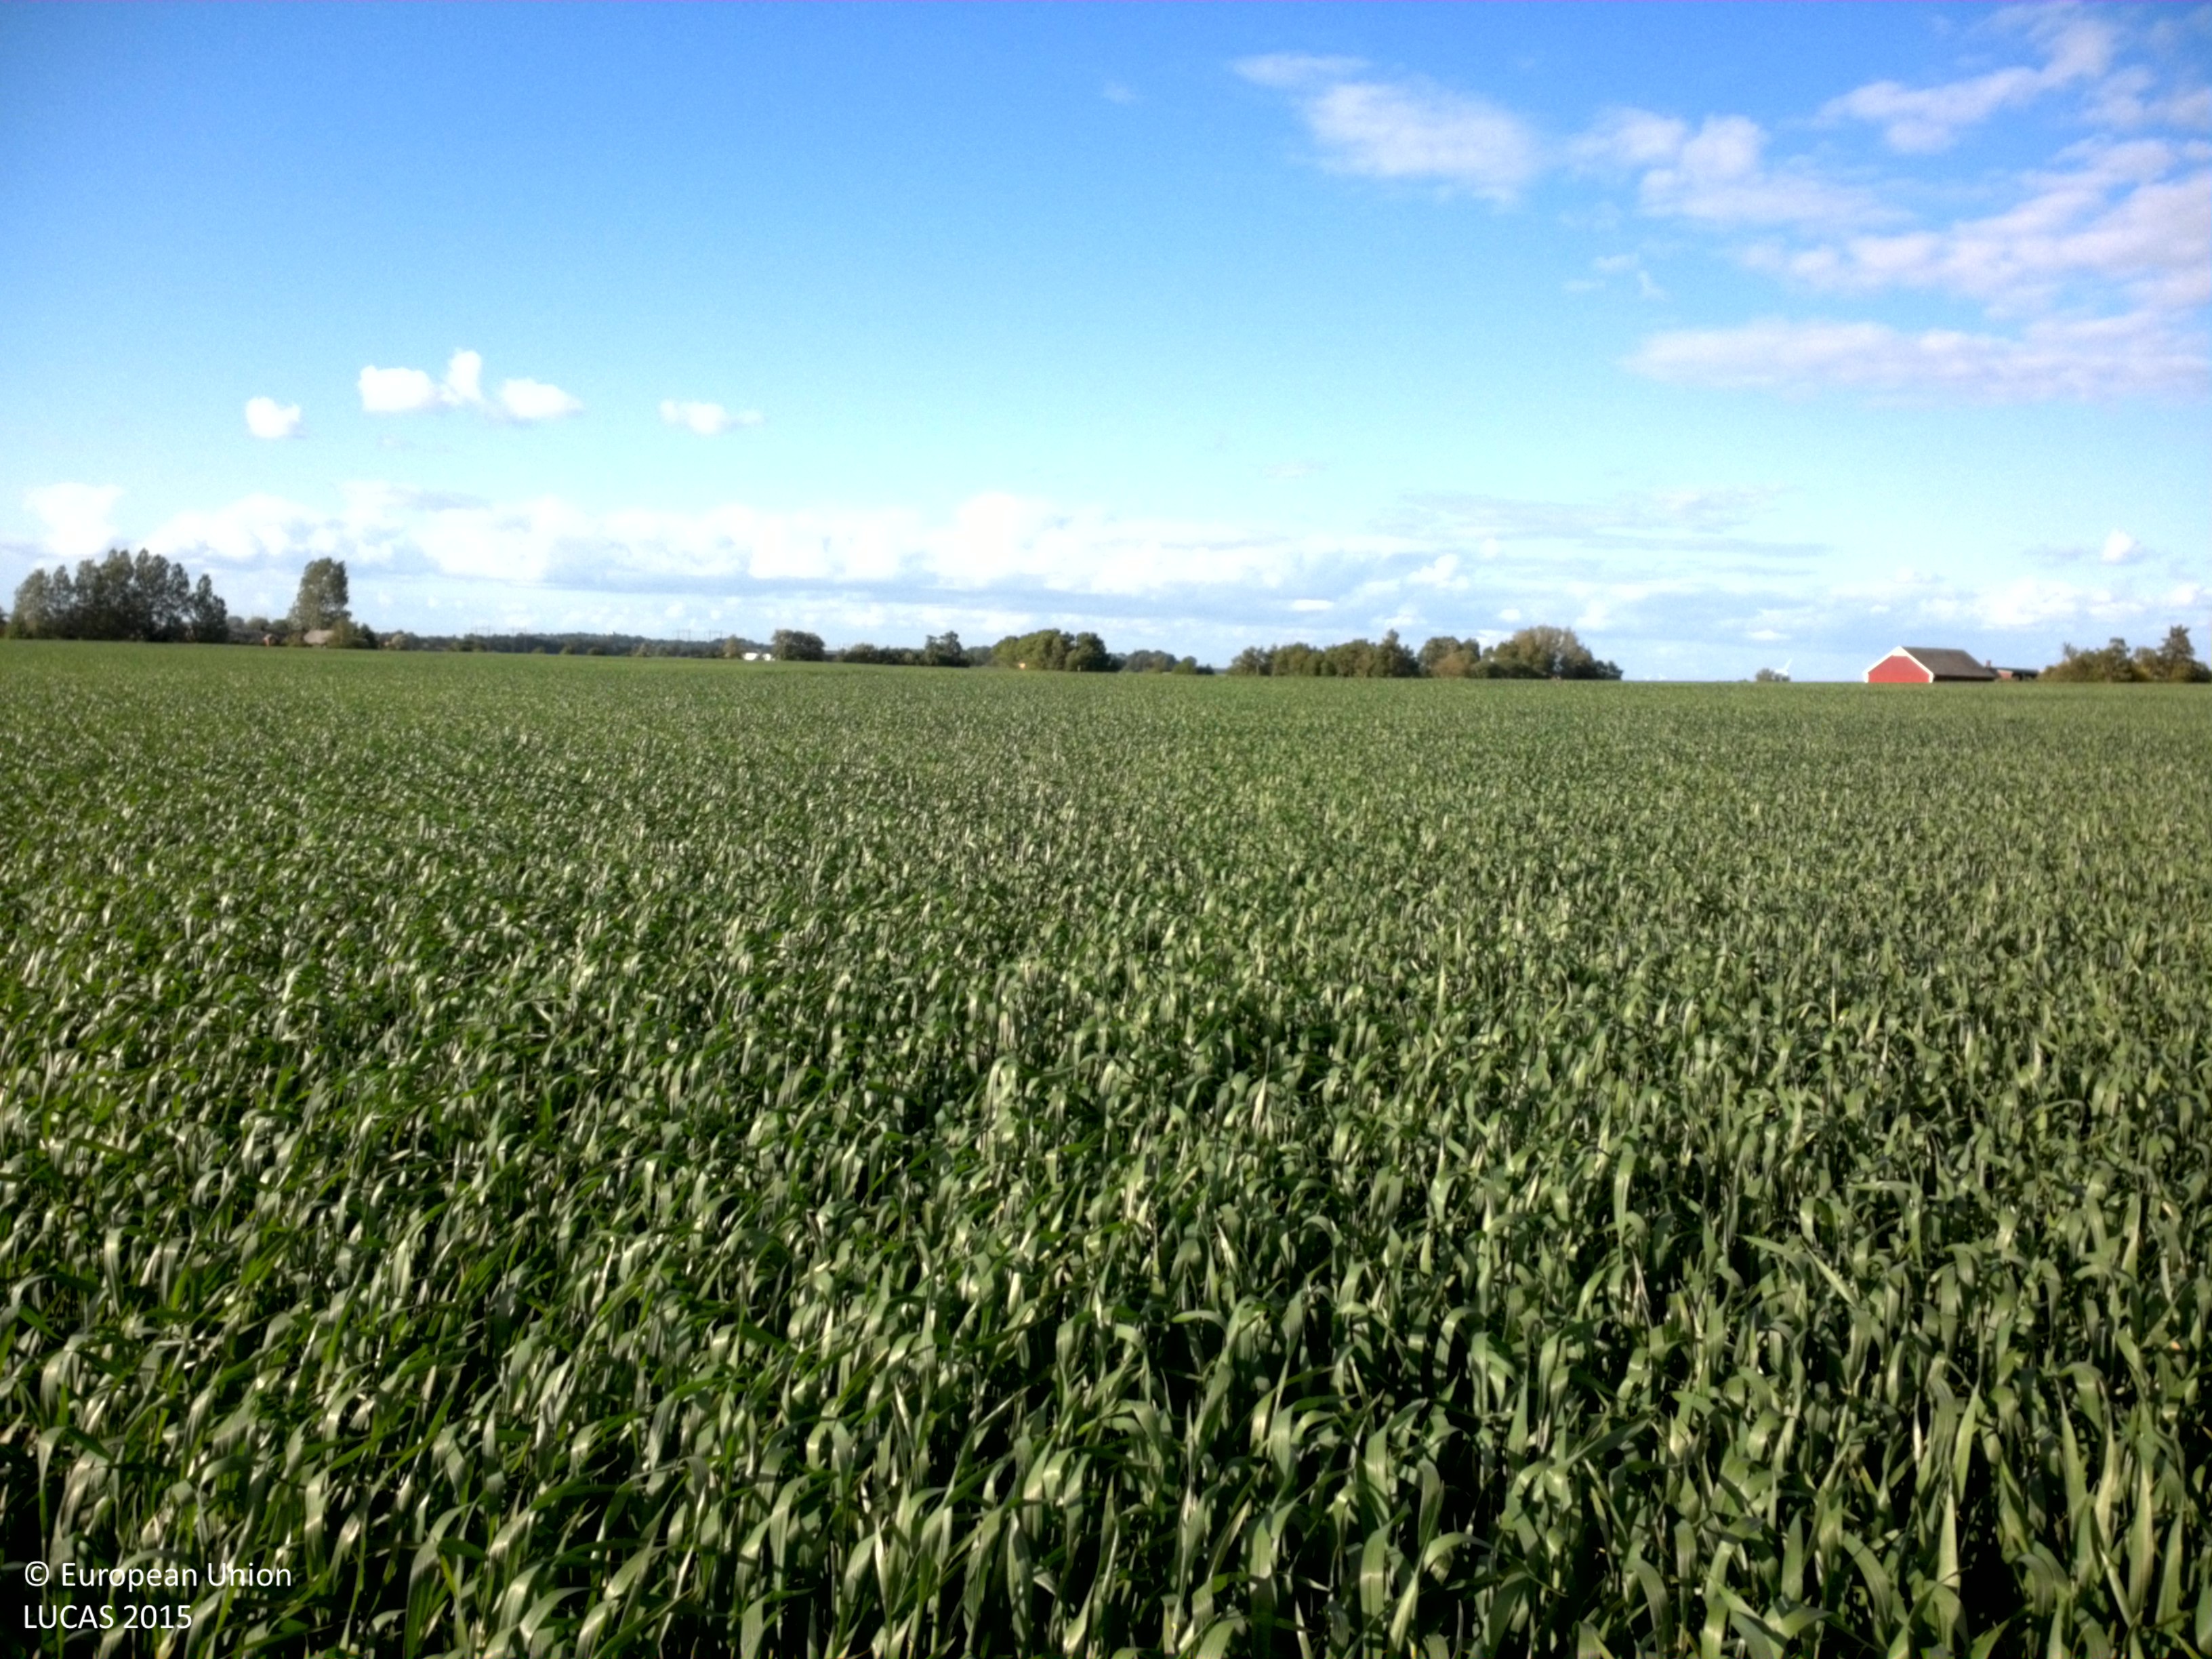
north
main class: Cropland
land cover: Common wheat
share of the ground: > 75 %
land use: Agriculture (excluding fallow land and kitchen gardens)
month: June
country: SE
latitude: 55.7919
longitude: 13.0441
